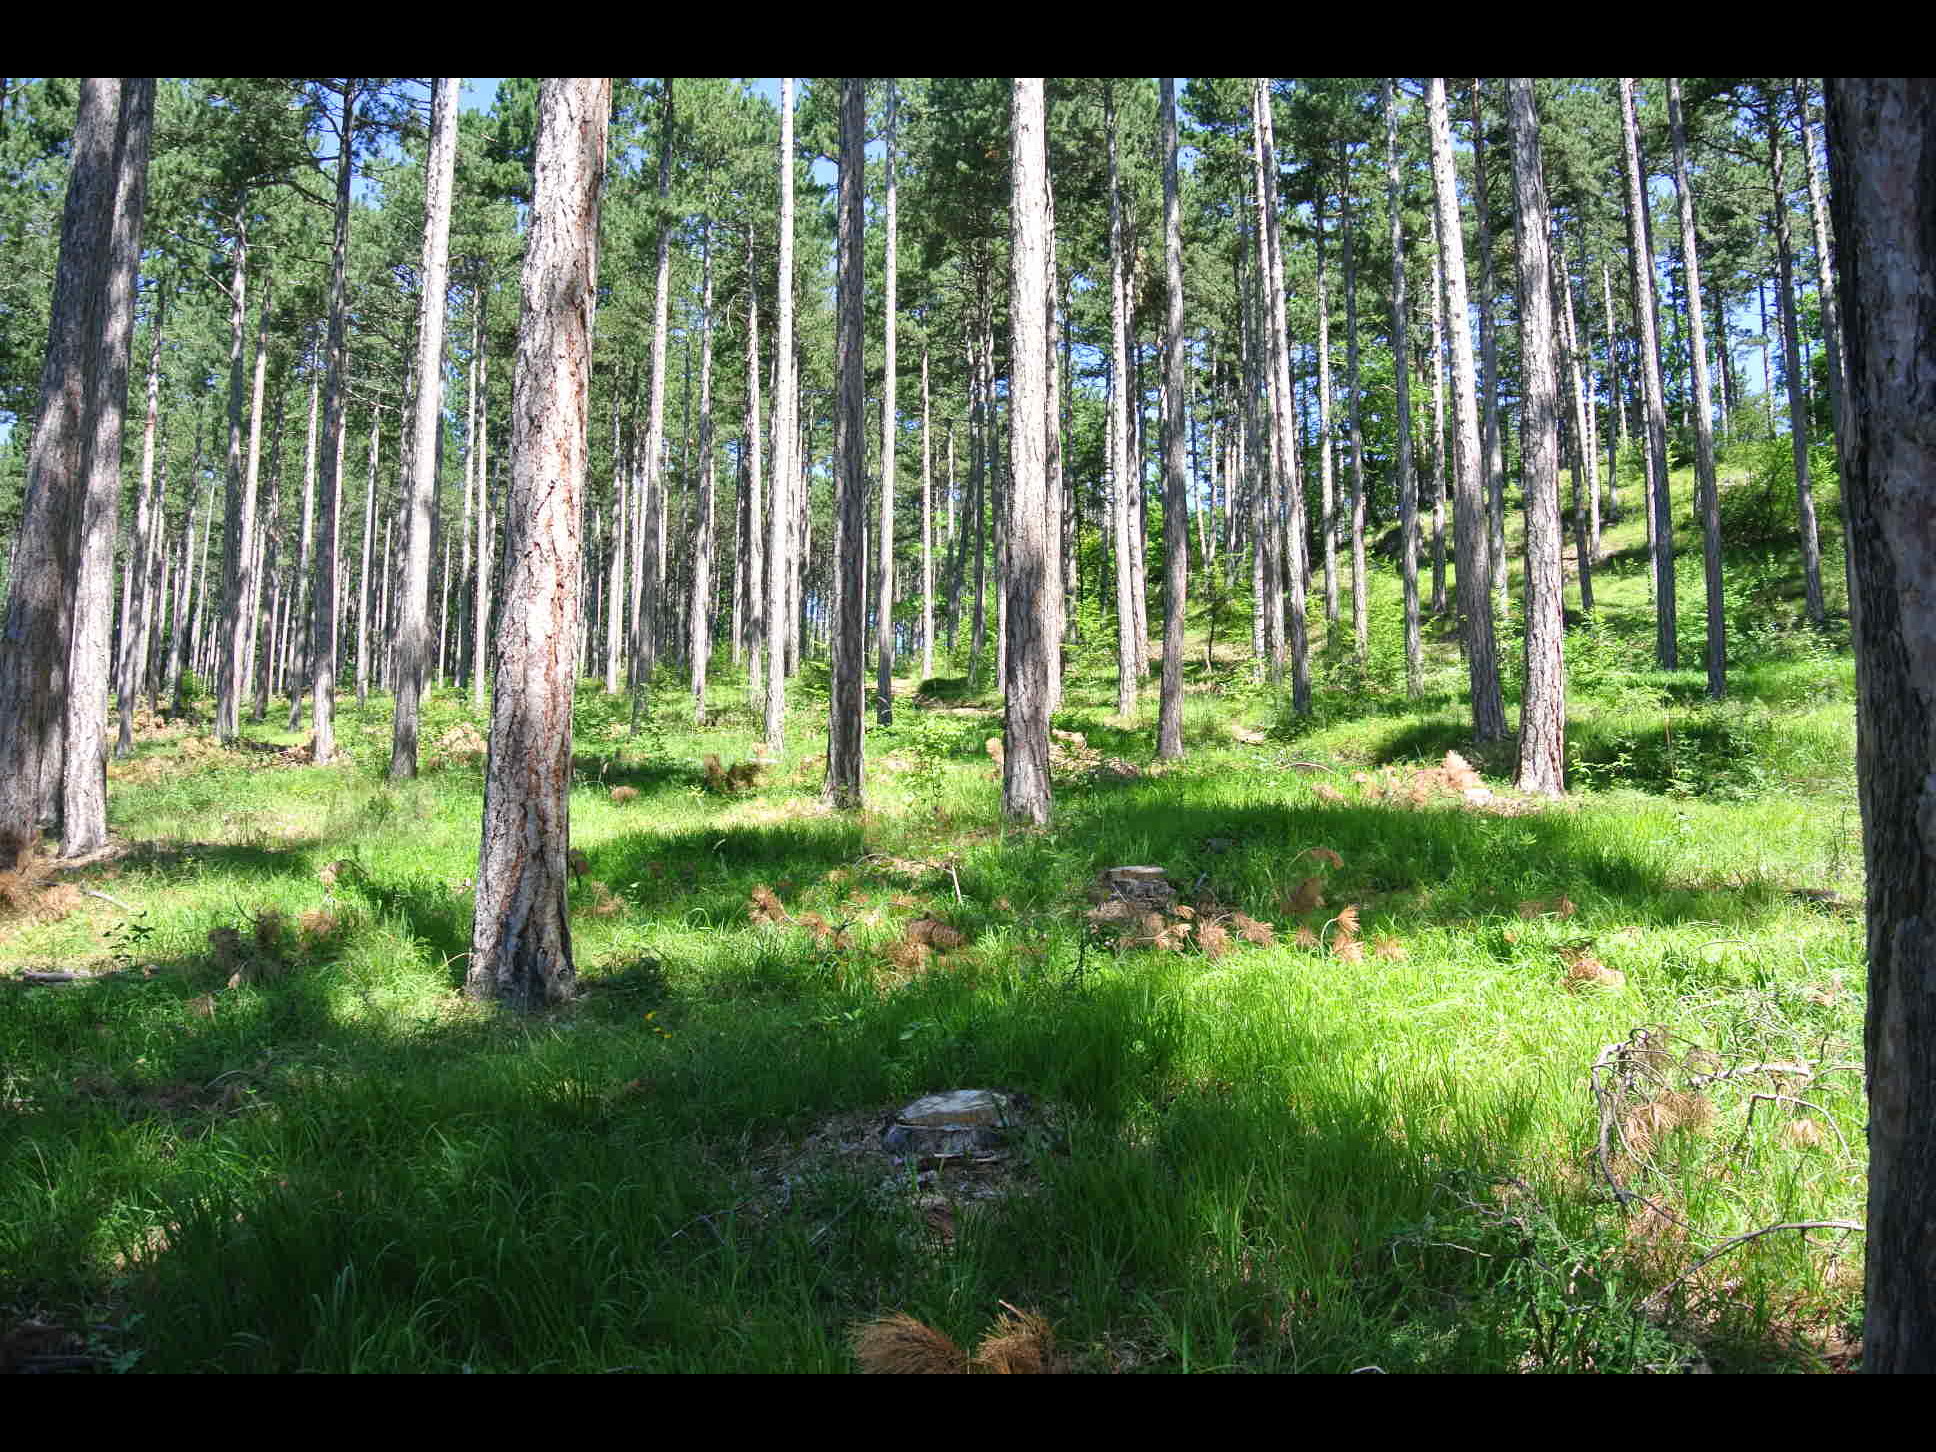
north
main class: Woodland
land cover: Pine dominated coniferous woodland
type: alpine coniferous forest
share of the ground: > 75 %
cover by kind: coniferous forest trees 100 %
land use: Forestry
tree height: > 5 m
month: July
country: AT
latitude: 47.7344
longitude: 16.0166
